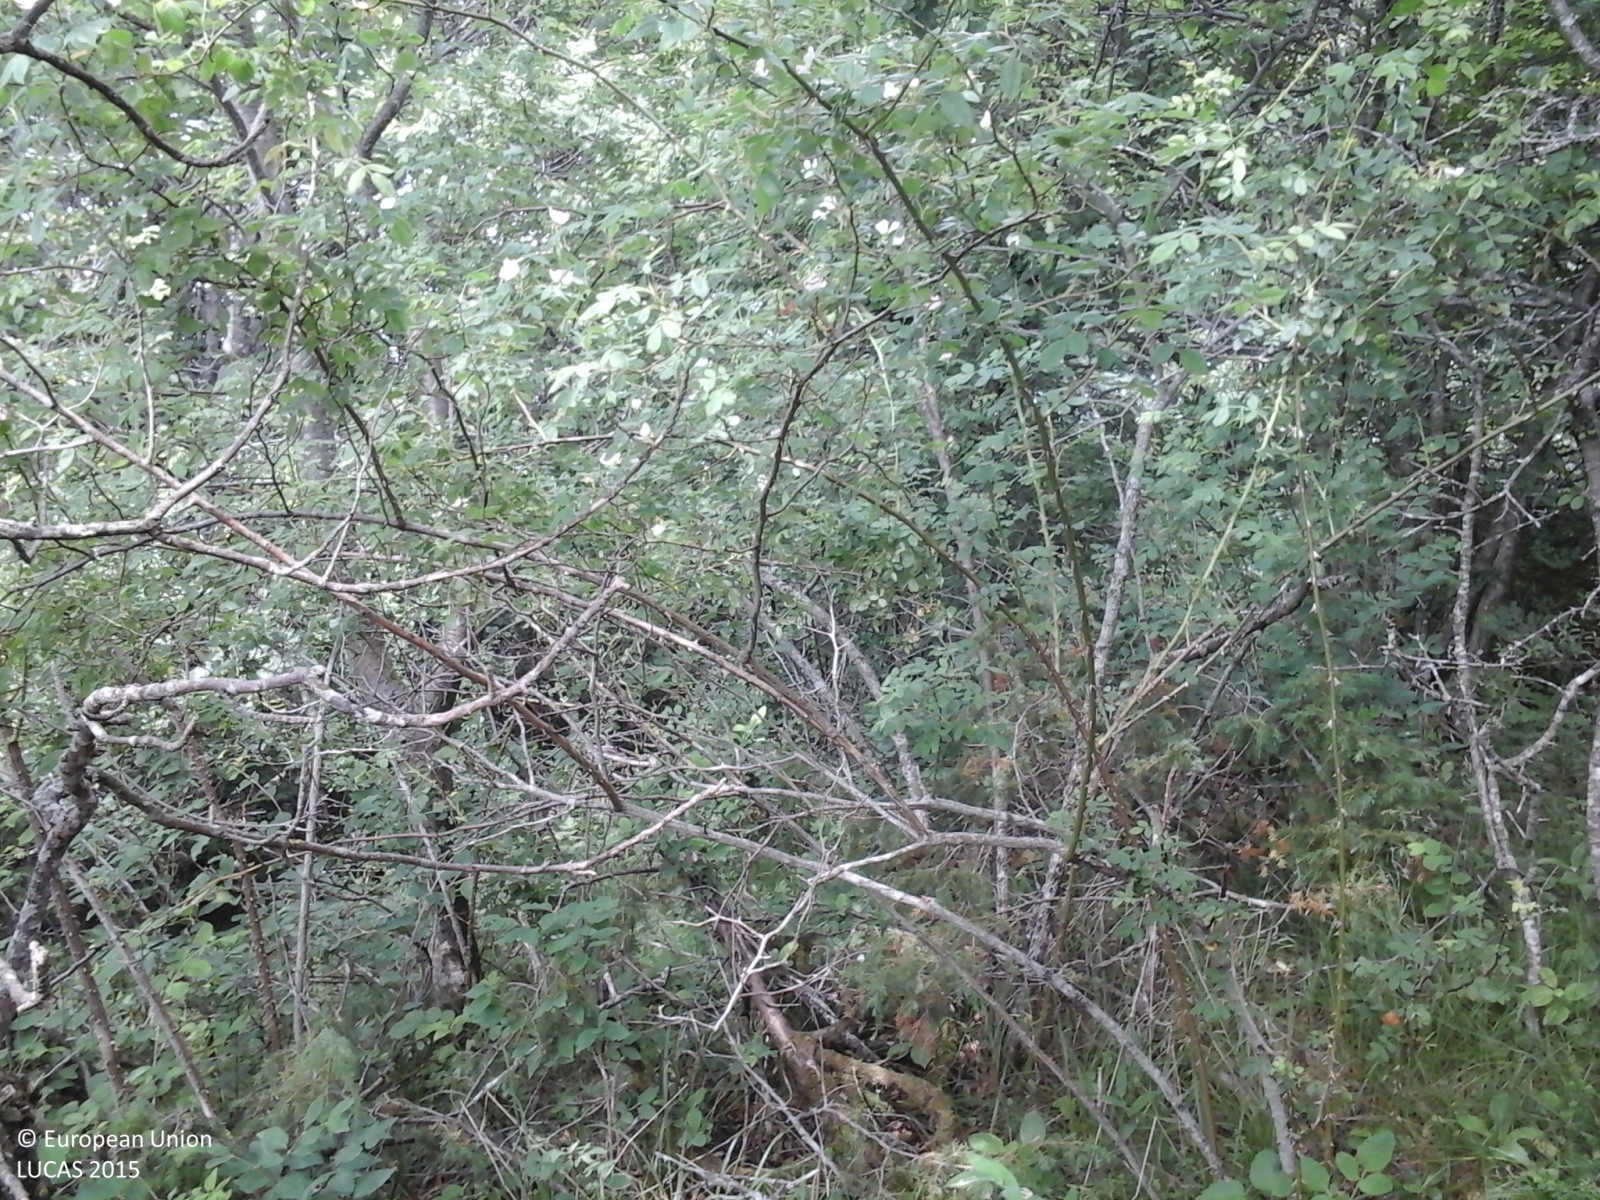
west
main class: Woodland
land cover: Broadleaved woodland
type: mesophytic deciduous forest
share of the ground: > 75 %
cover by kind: broadleaved forest trees 100 %
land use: Semi-natural and natural areas not in use
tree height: > 5 m
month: June
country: IT
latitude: 46.0177
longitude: 12.4123
